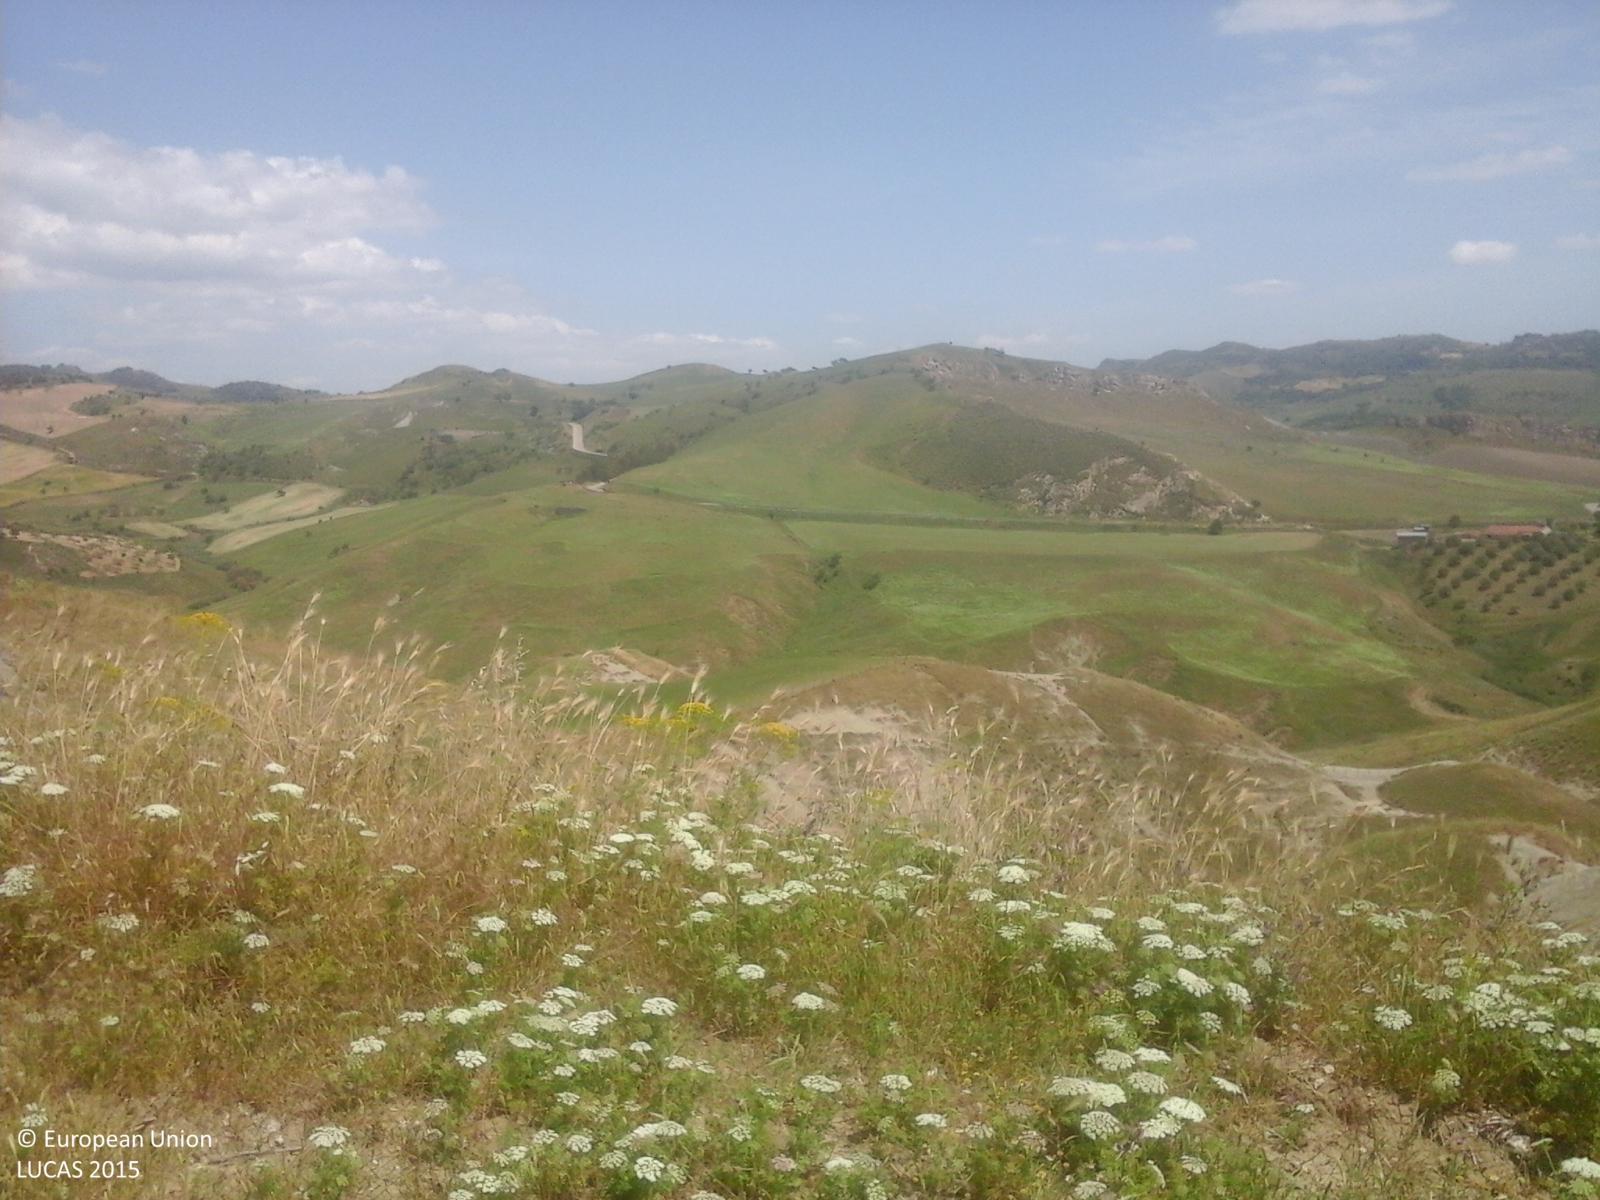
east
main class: Grassland
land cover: Grassland without tree/shrub cover
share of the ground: > 75 %
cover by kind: herbaceous plants 100 %
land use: Agriculture (excluding fallow land and kitchen gardens)
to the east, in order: Grassland without tree/shrub cover; Tracks; Grassland without tree/shrub cover; Permanent crops (only in case pi); Grassland without tree/shrub cover; Permanent crops (only in case pi); Grassland without tree/shrub cover; Rocks and stones; Grassland without tree/shrub cover
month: May
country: IT
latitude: 37.6549
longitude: 14.1974
